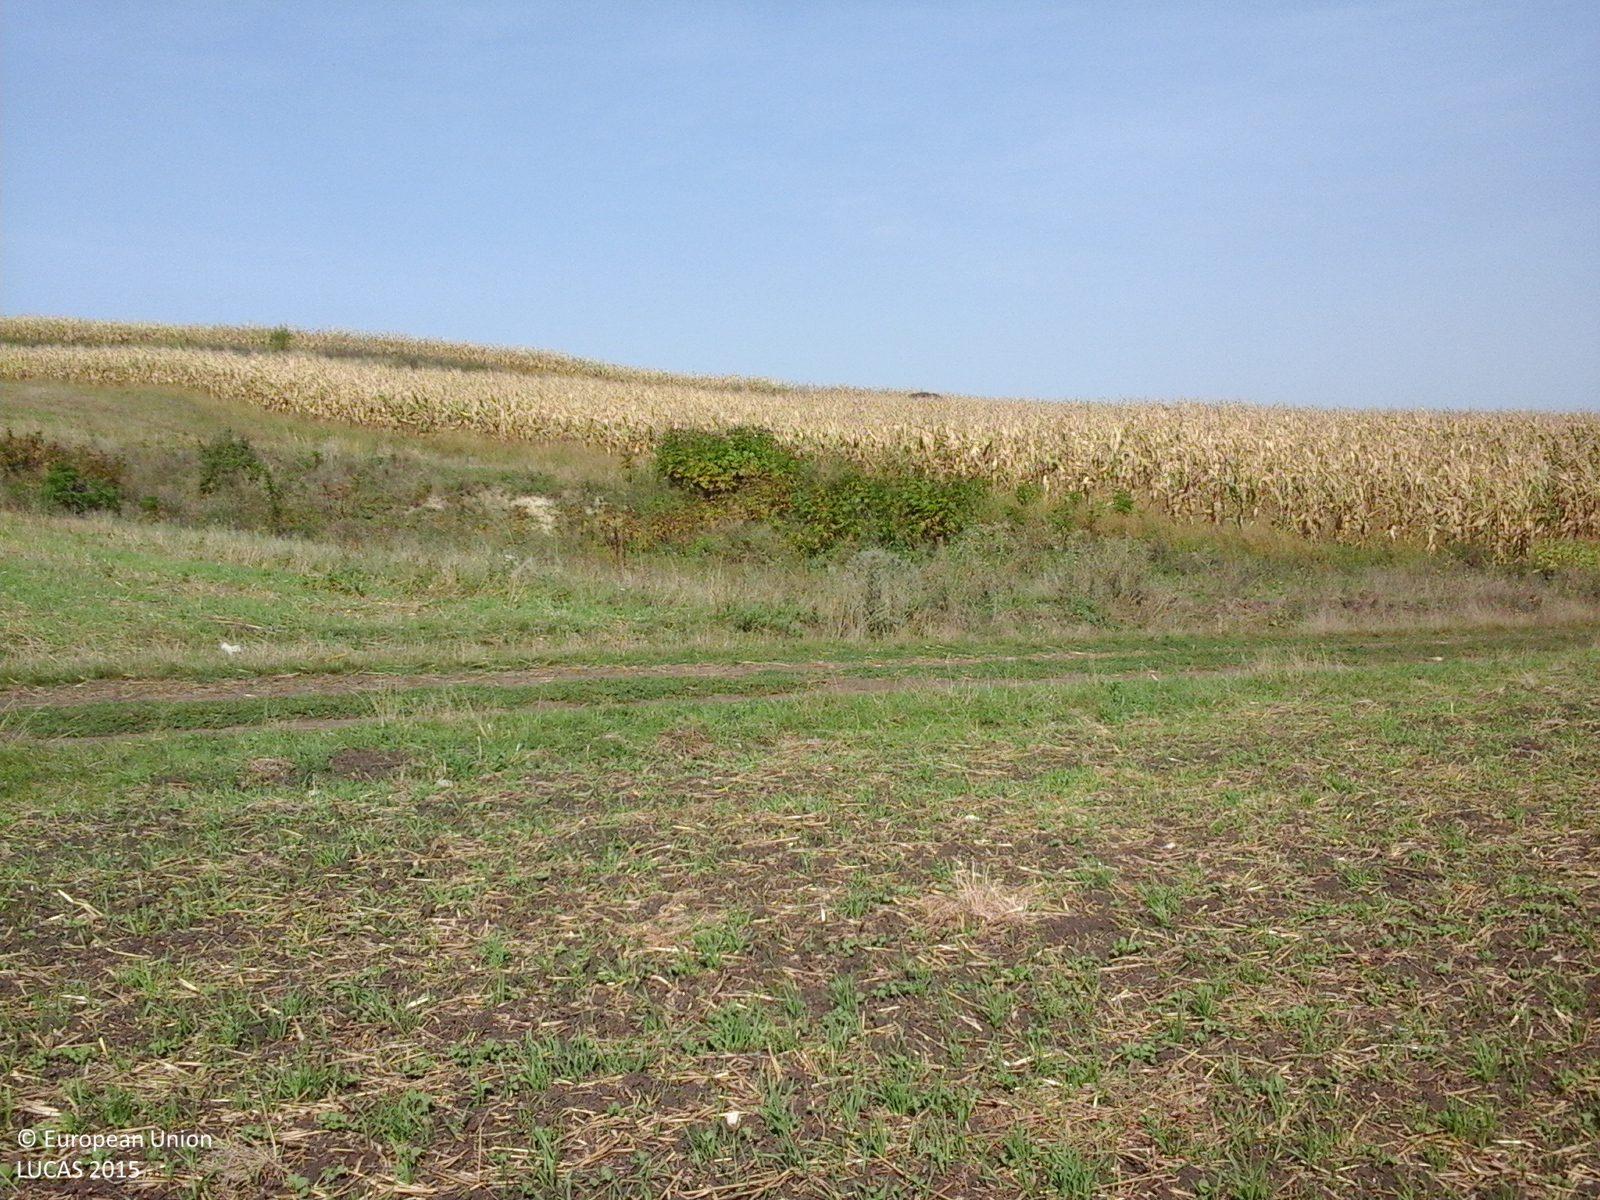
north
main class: Cropland
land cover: Rye
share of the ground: 25 - 50 %
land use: Agriculture (excluding fallow land and kitchen gardens)
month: September
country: RO
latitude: 46.6464
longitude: 24.0189
